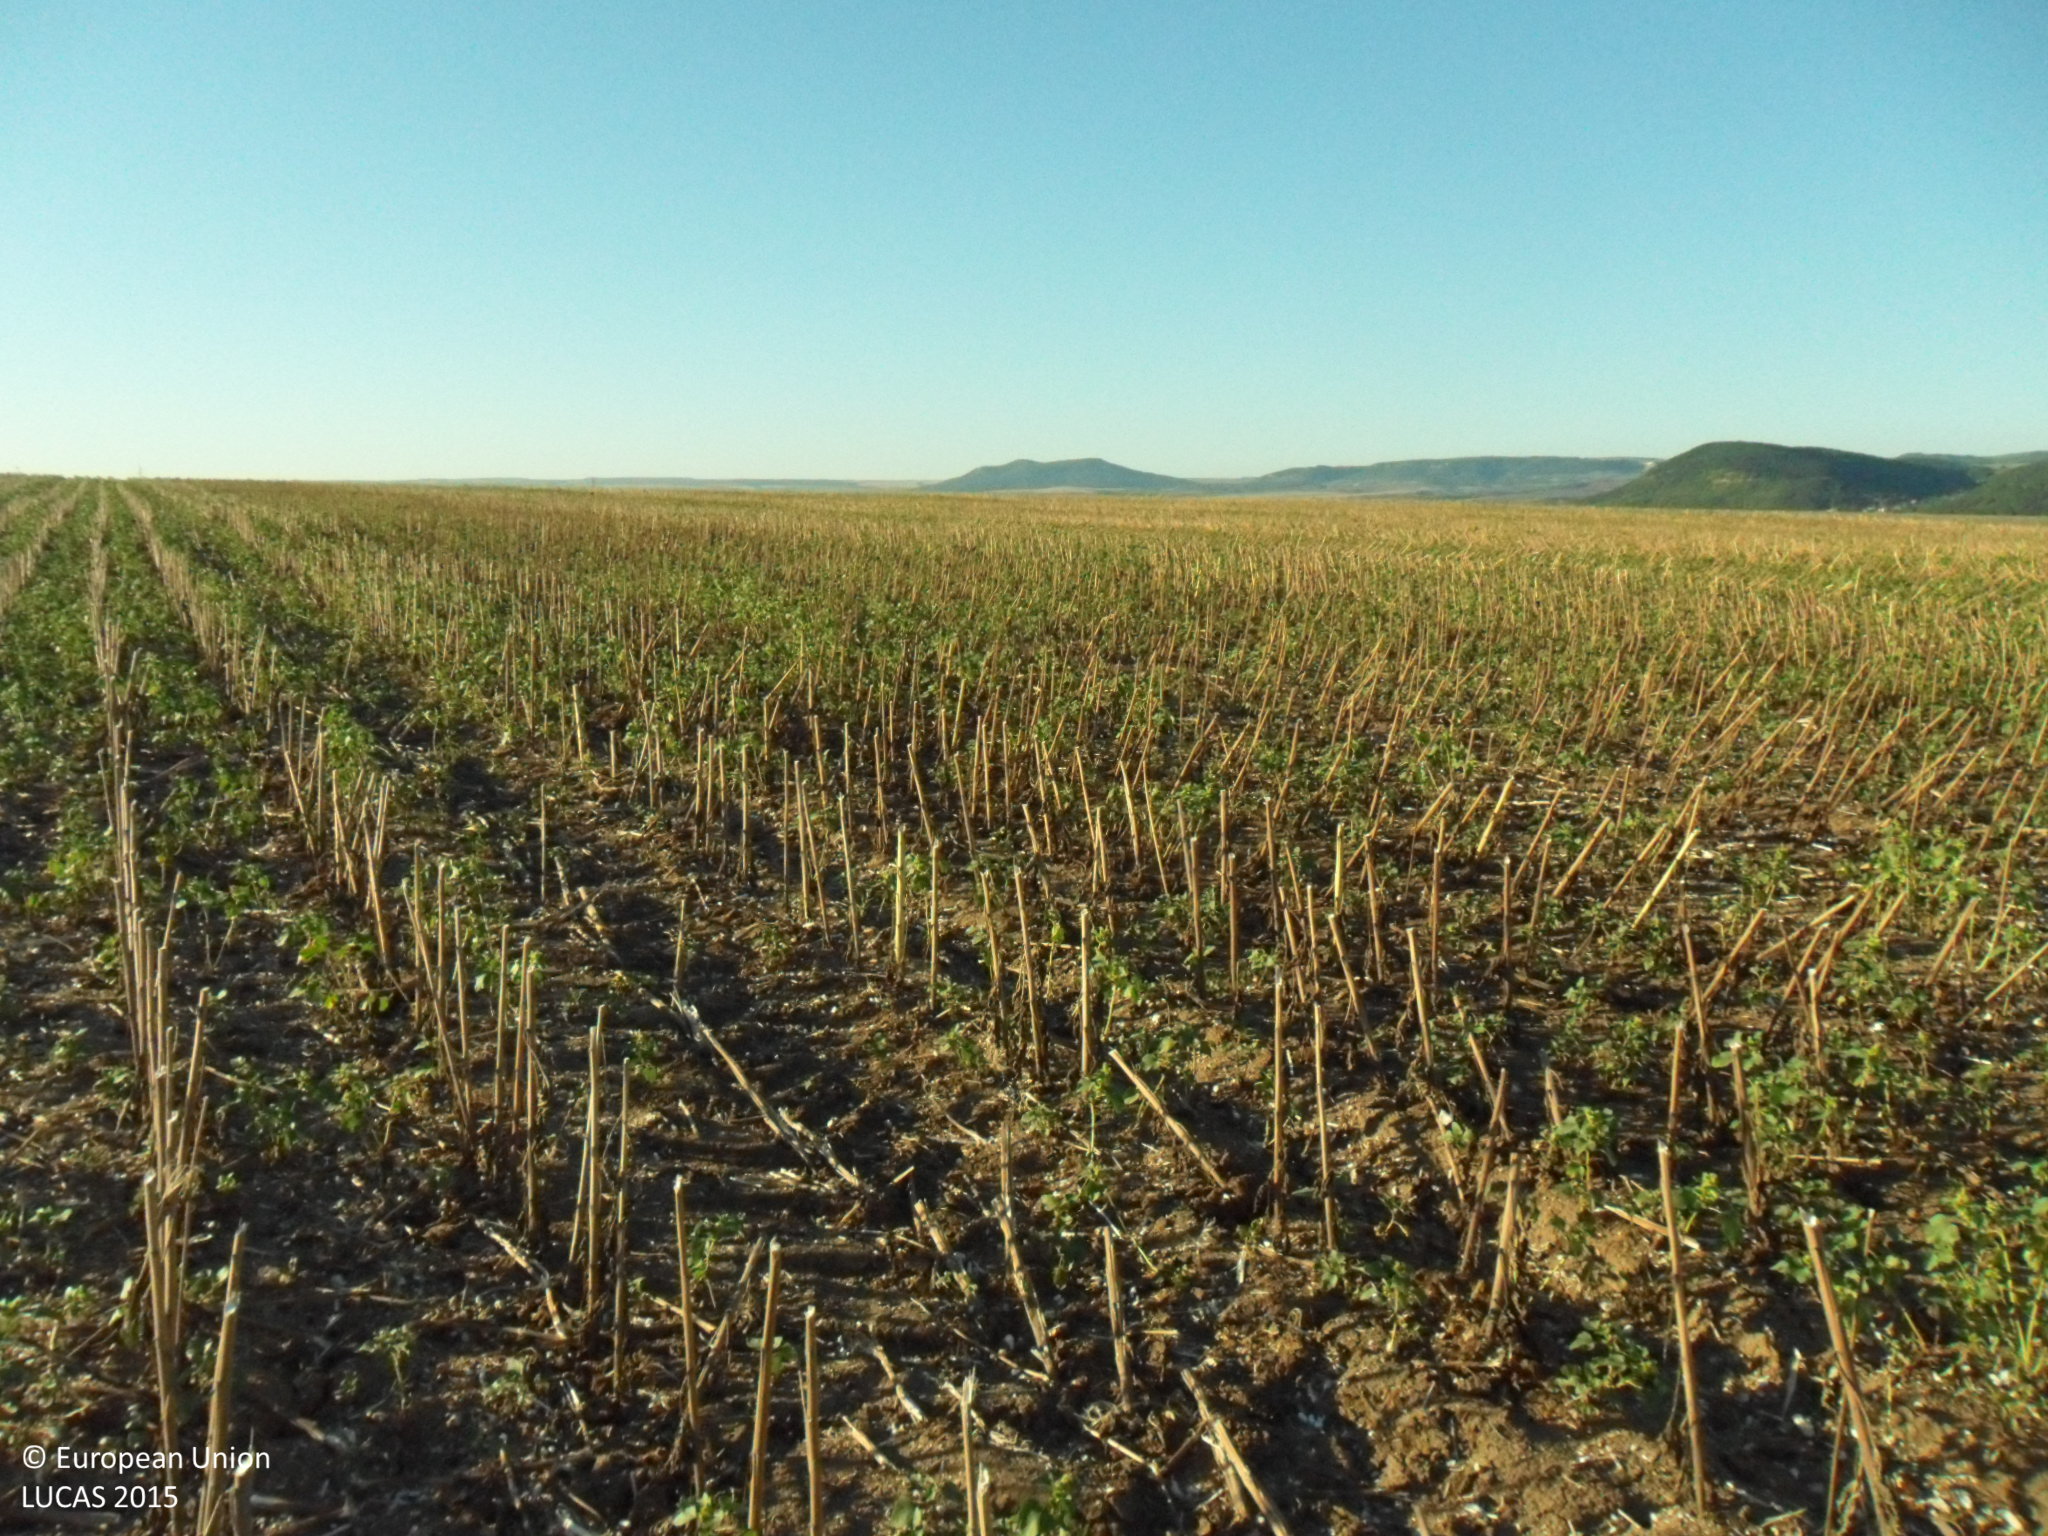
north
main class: Cropland
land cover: Sunflower
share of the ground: 10 - 25 %
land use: Agriculture (excluding fallow land and kitchen gardens)
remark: Harvested field
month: September
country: BG
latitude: 43.1927
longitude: 26.7816
